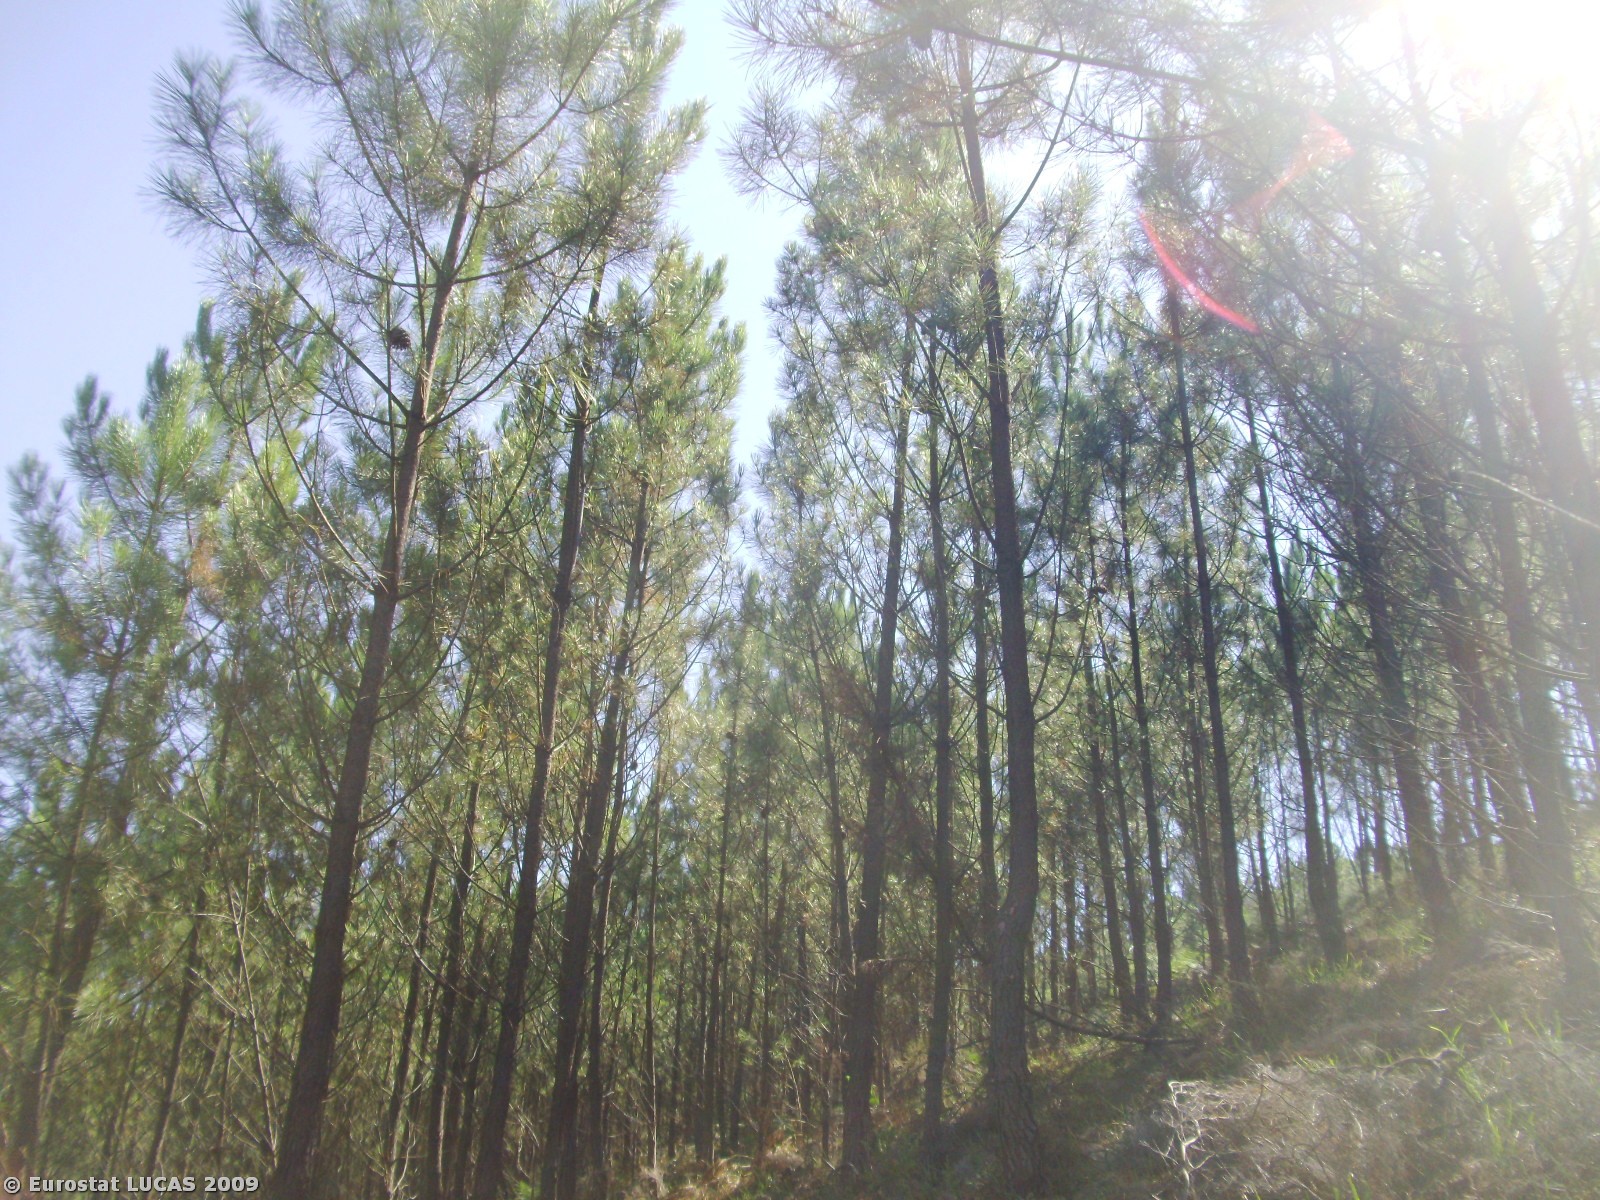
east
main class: Woodland
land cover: Coniferous woodland
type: coniferous forest of the mediterranean region
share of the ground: > 75 %
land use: Forestry
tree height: > 5 m
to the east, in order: Coniferous woodland; Tracks; Coniferous woodland; Tracks; Shrubland without tree cover; Coniferous woodland
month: August
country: PT
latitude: 41.3517
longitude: -7.9334
